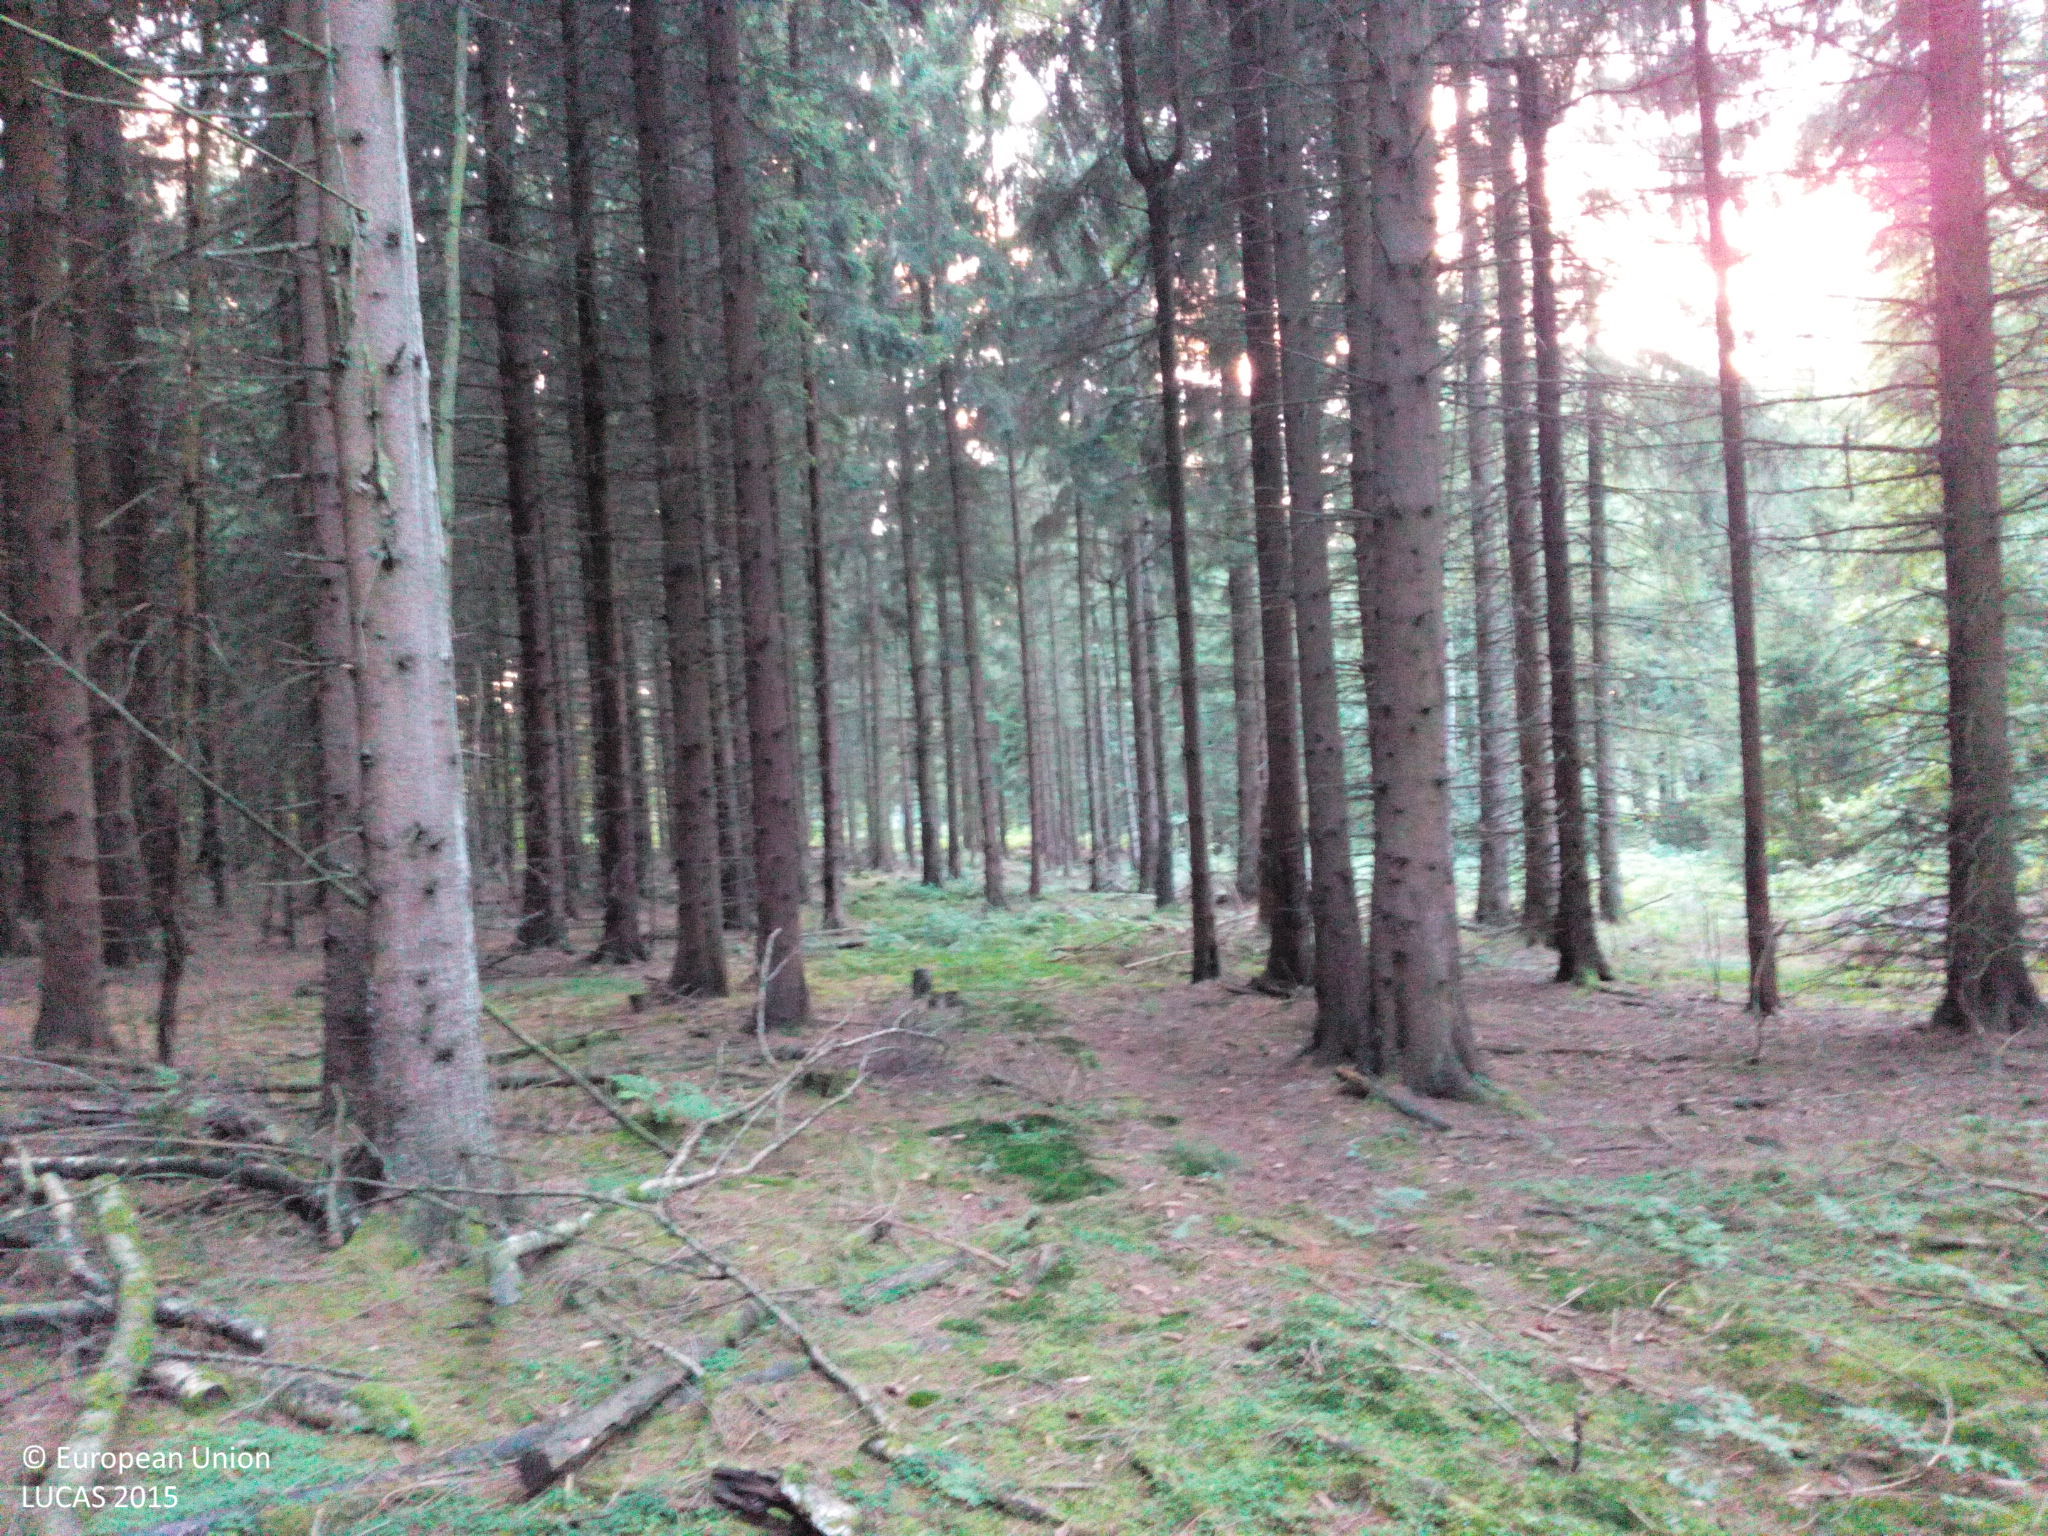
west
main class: Woodland
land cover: Spruce dominated coniferous woodland
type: hemiboreal forest and nemoral coniferous forest and mixed broadleaved-coniferous forest
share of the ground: > 75 %
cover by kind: coniferous forest trees 100 %
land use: Forestry
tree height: > 5 m
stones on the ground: < 10 %
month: September
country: DE
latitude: 51.5274
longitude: 11.1096
